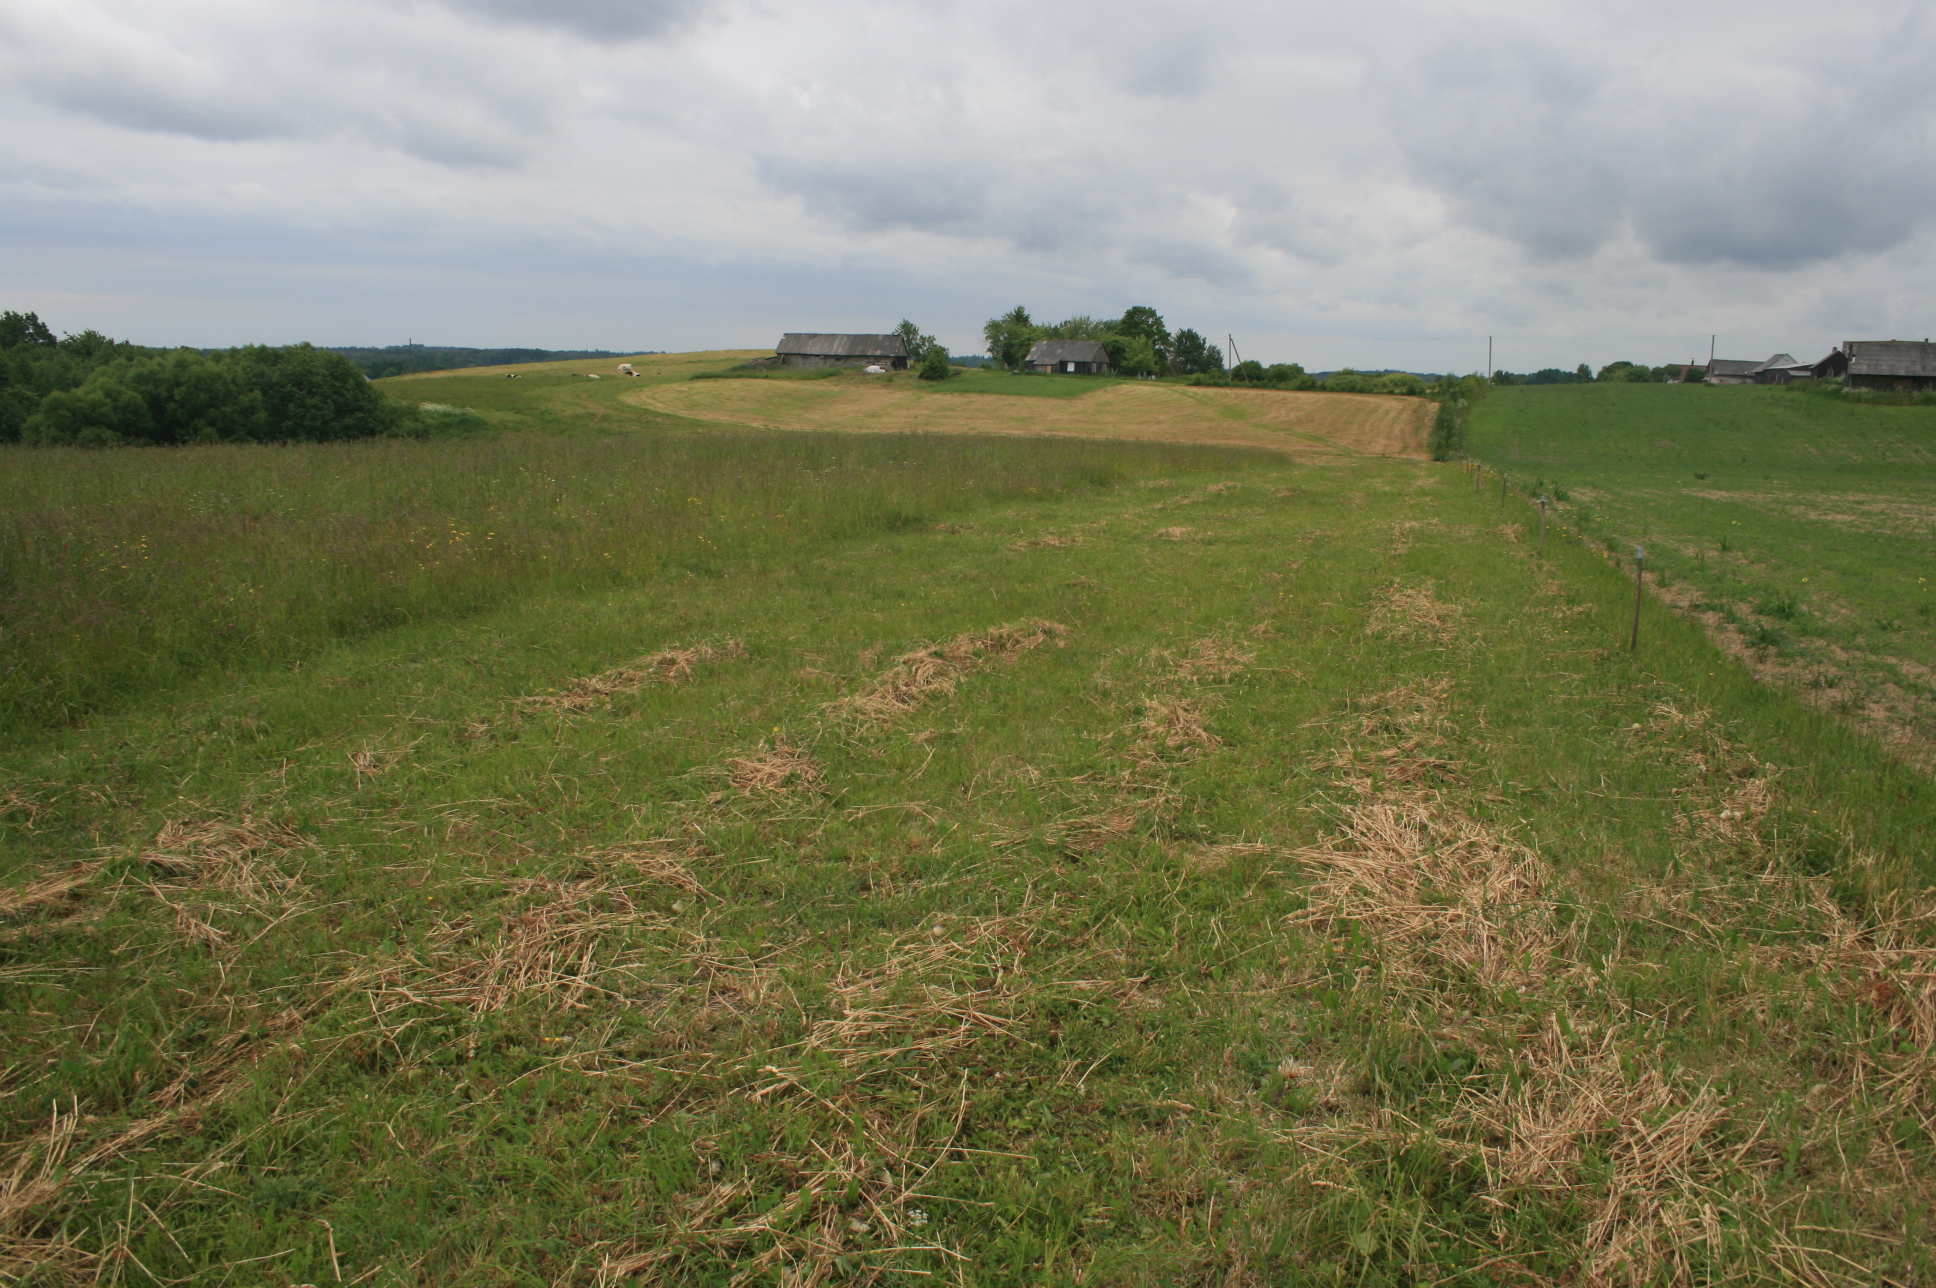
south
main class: Grassland
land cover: Grassland without tree/shrub cover
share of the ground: > 75 %
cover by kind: herbaceous plants 100 %
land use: Agriculture (excluding fallow land and kitchen gardens)
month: June
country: LT
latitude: 55.5848
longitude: 22.3859
